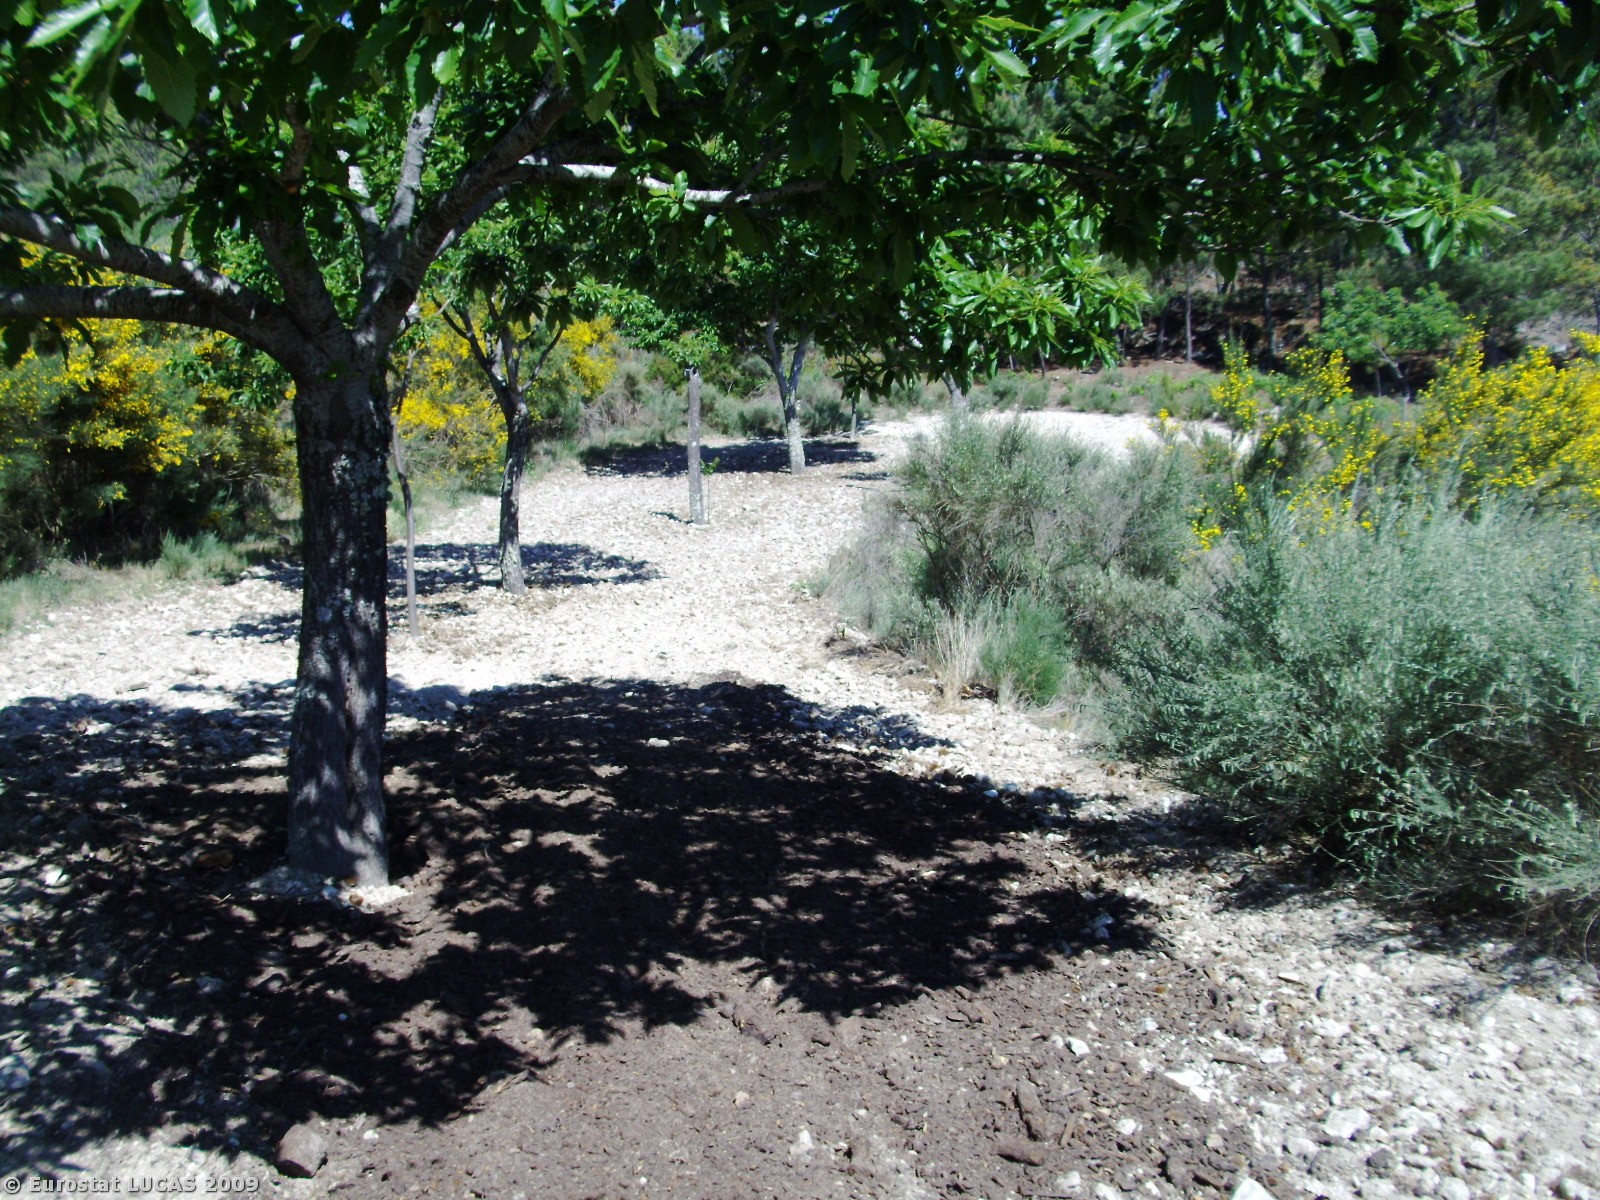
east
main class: Cropland
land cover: Nuts trees
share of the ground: 25 - 50 %
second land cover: Bare land
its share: 25 - 50 %
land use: Agriculture (excluding fallow land and kitchen gardens)
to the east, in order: Nuts trees; Bare land; Nuts trees; Shrubland with sparse tree cover; Dry stone walls; Coniferous woodland; Tracks; Shrubland with sparse tree cover; Coniferous woodland
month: May
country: PT
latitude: 40.9032
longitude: -7.5579
